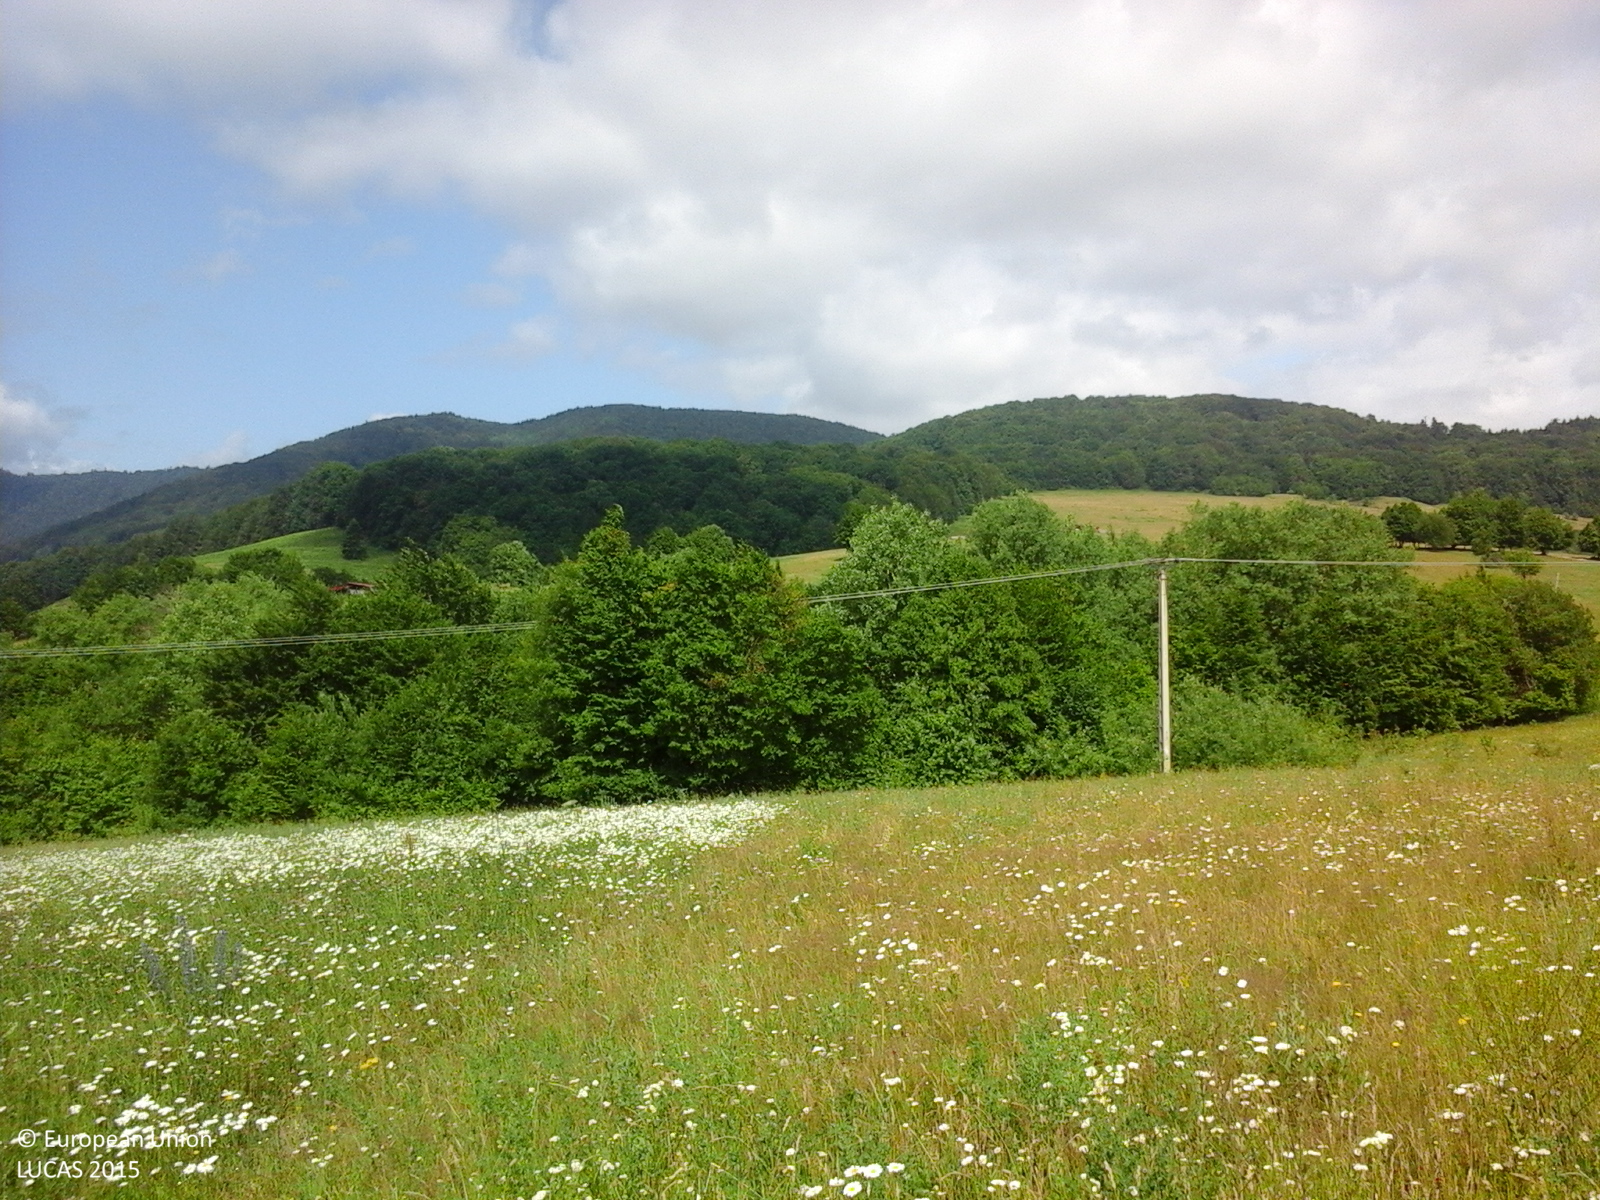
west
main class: Cropland
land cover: Other leguminous and mixtures for fodder
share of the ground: > 75 %
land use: Agriculture (excluding fallow land and kitchen gardens)
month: June
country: RO
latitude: 47.0702
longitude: 26.3177
